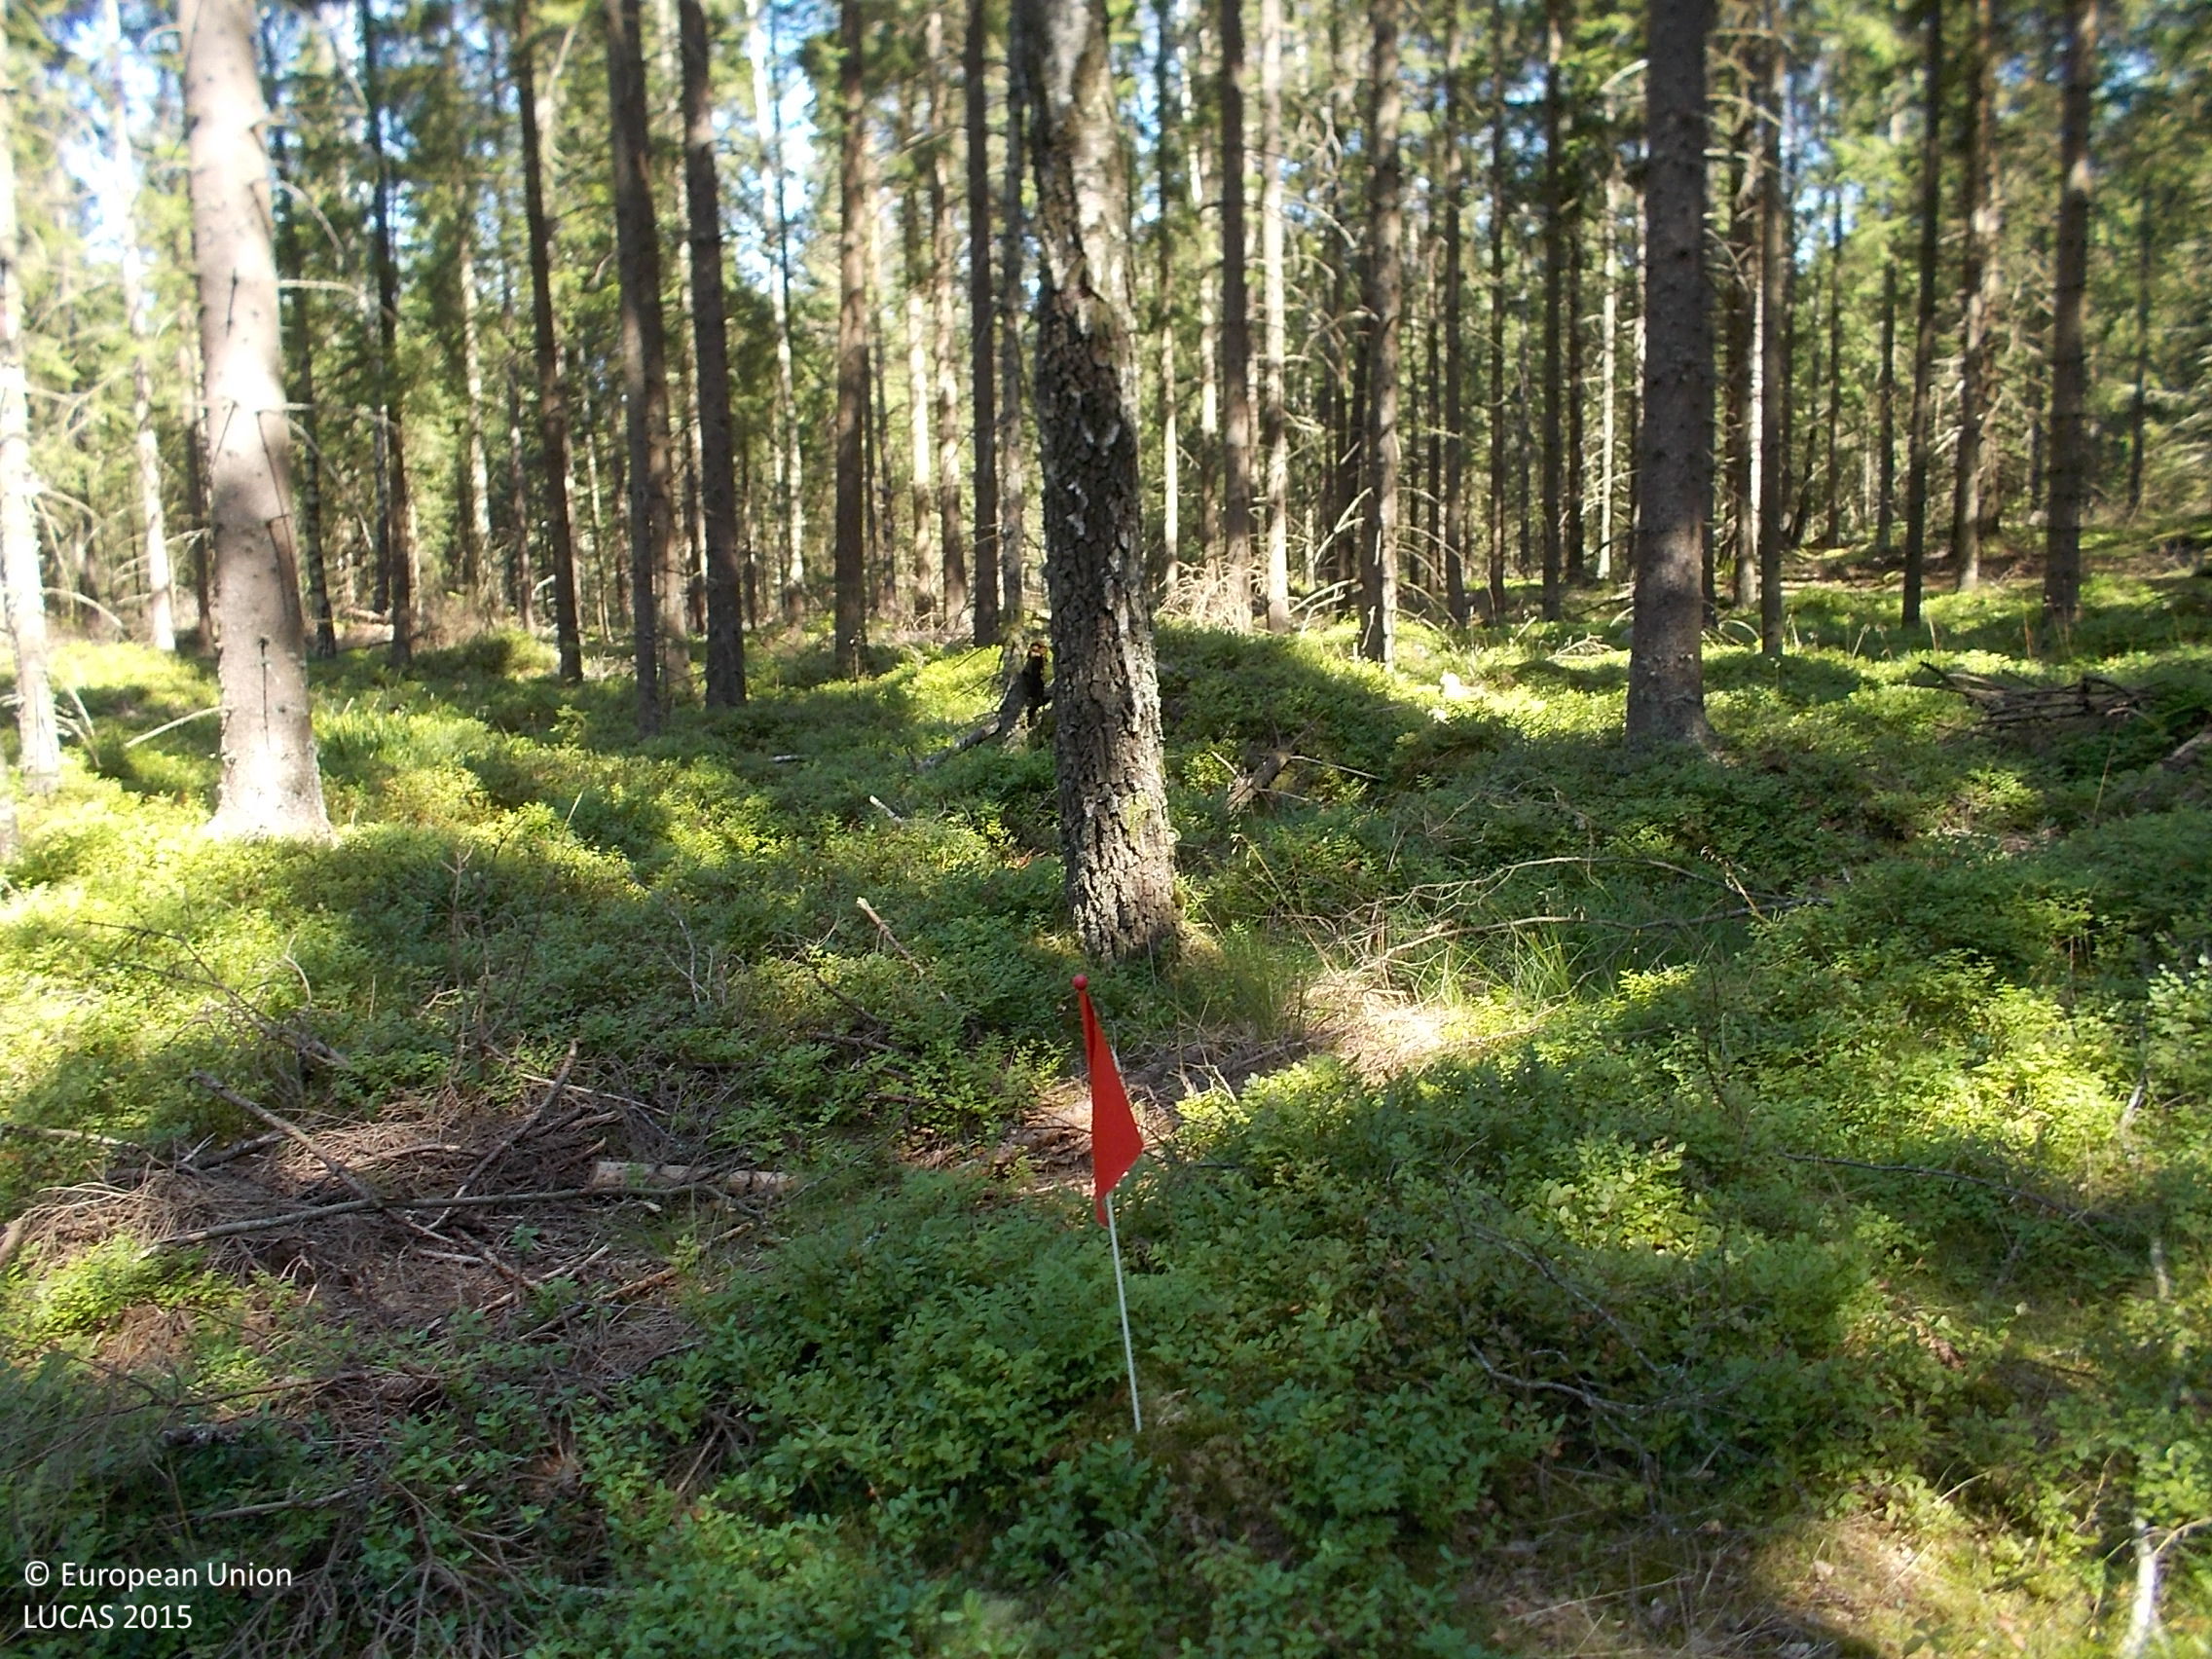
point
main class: Woodland
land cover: Spruce dominated coniferous woodland
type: boreal forest
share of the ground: > 75 %
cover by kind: coniferous forest trees 85 %, shrubs 10 %, herbaceous plants 5 %
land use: Forestry
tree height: > 5 m
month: August
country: SE
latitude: 57.4783
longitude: 13.2478
